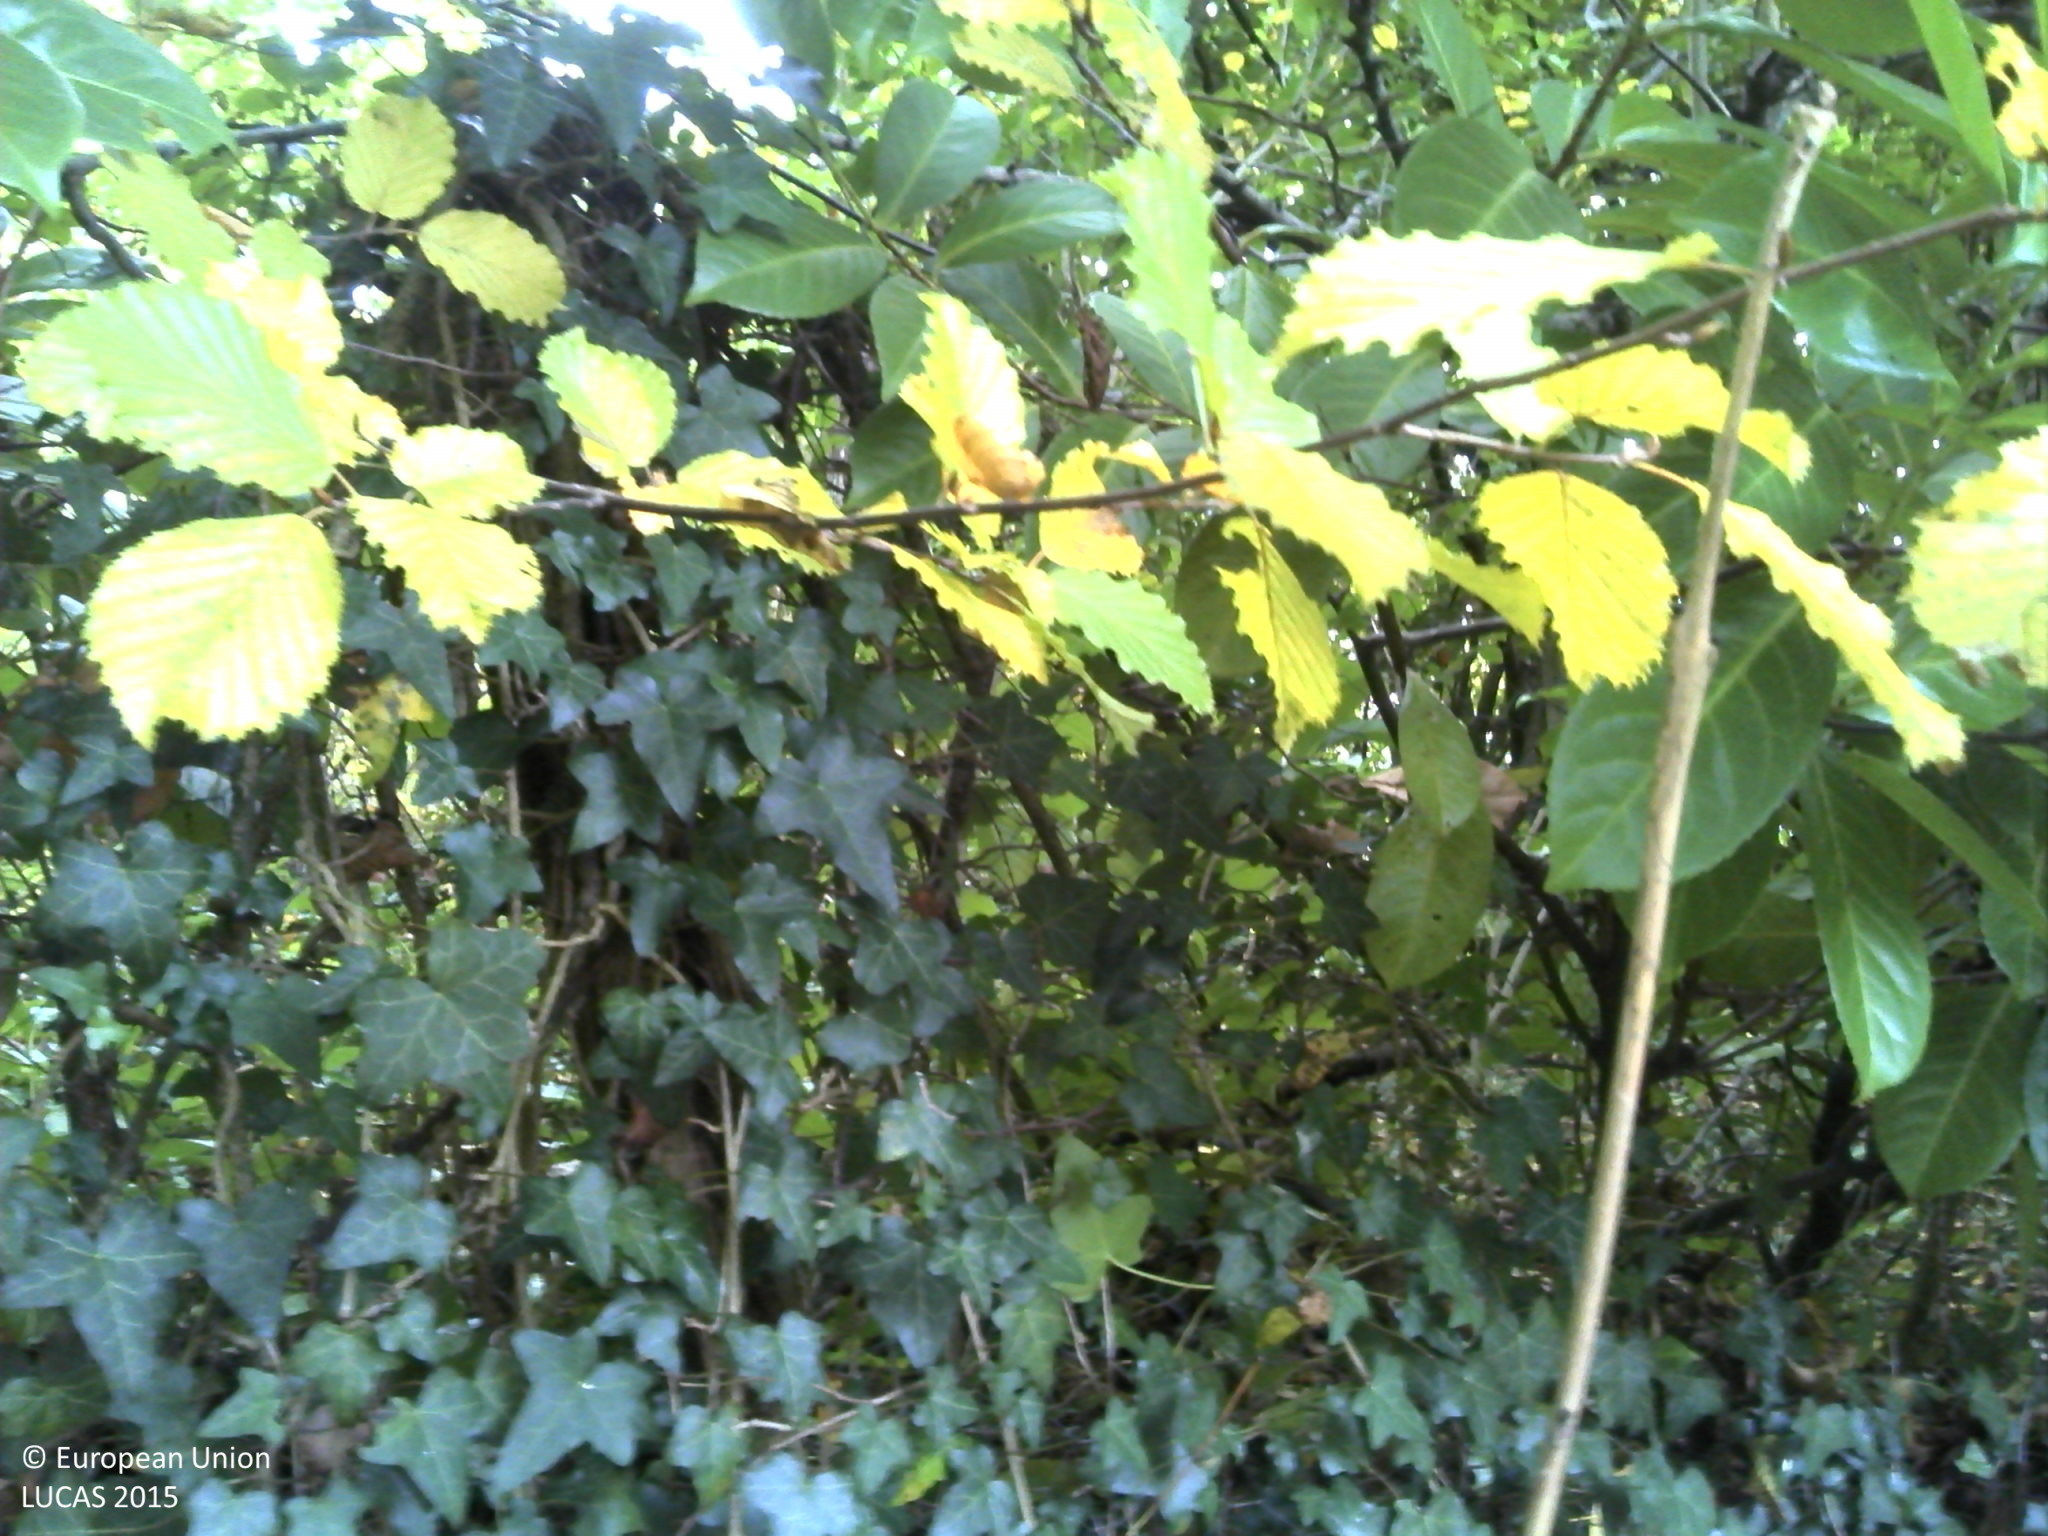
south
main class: Woodland
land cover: Broadleaved woodland
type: mesophytic deciduous forest
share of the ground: > 75 %
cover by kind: broadleaved forest trees 90 %, shrubs 5 %, herbaceous plants 5 %
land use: Forestry
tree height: > 5 m
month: October
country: FR
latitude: 46.0534
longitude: 5.3892
